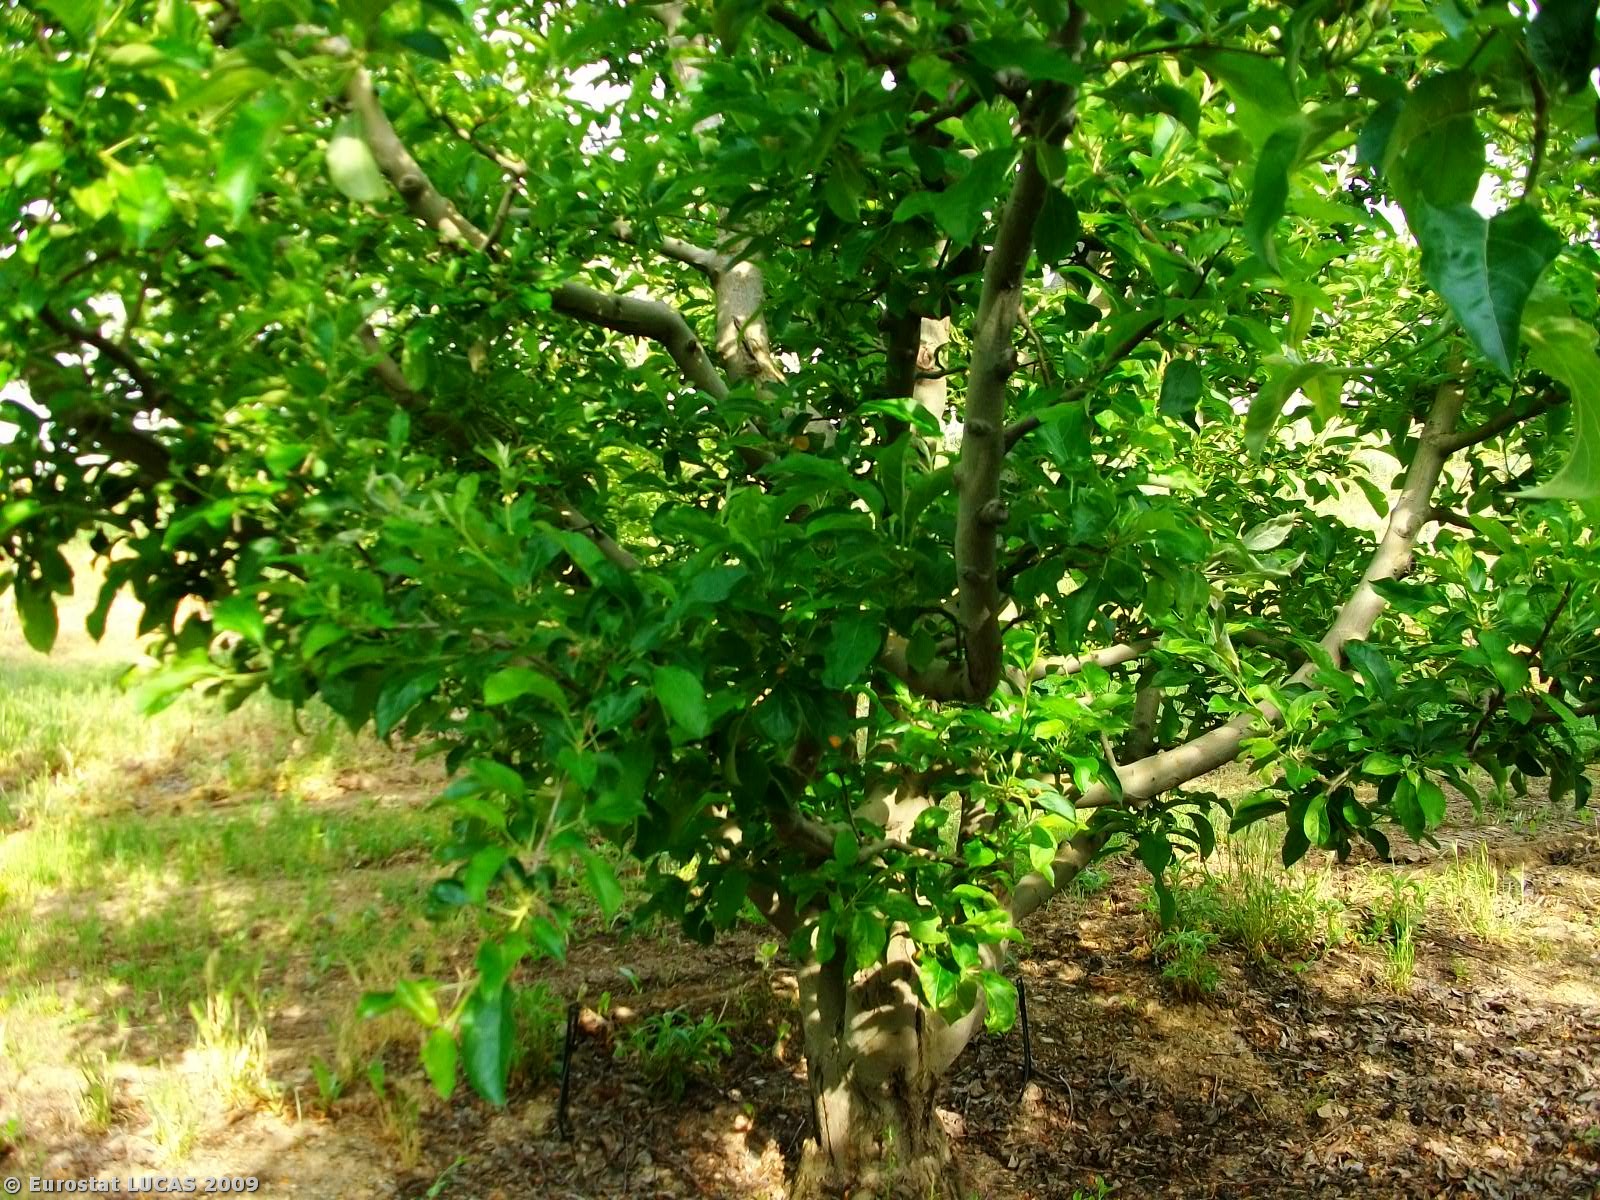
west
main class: Cropland
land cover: Apple fruit
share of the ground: > 75 %
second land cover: Grassland with sparse tree/shrub cover
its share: 50 - 75 %
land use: Agriculture (excluding fallow land and kitchen gardens)
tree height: > 5 m
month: May
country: GR
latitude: 40.7335
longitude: 21.8498
